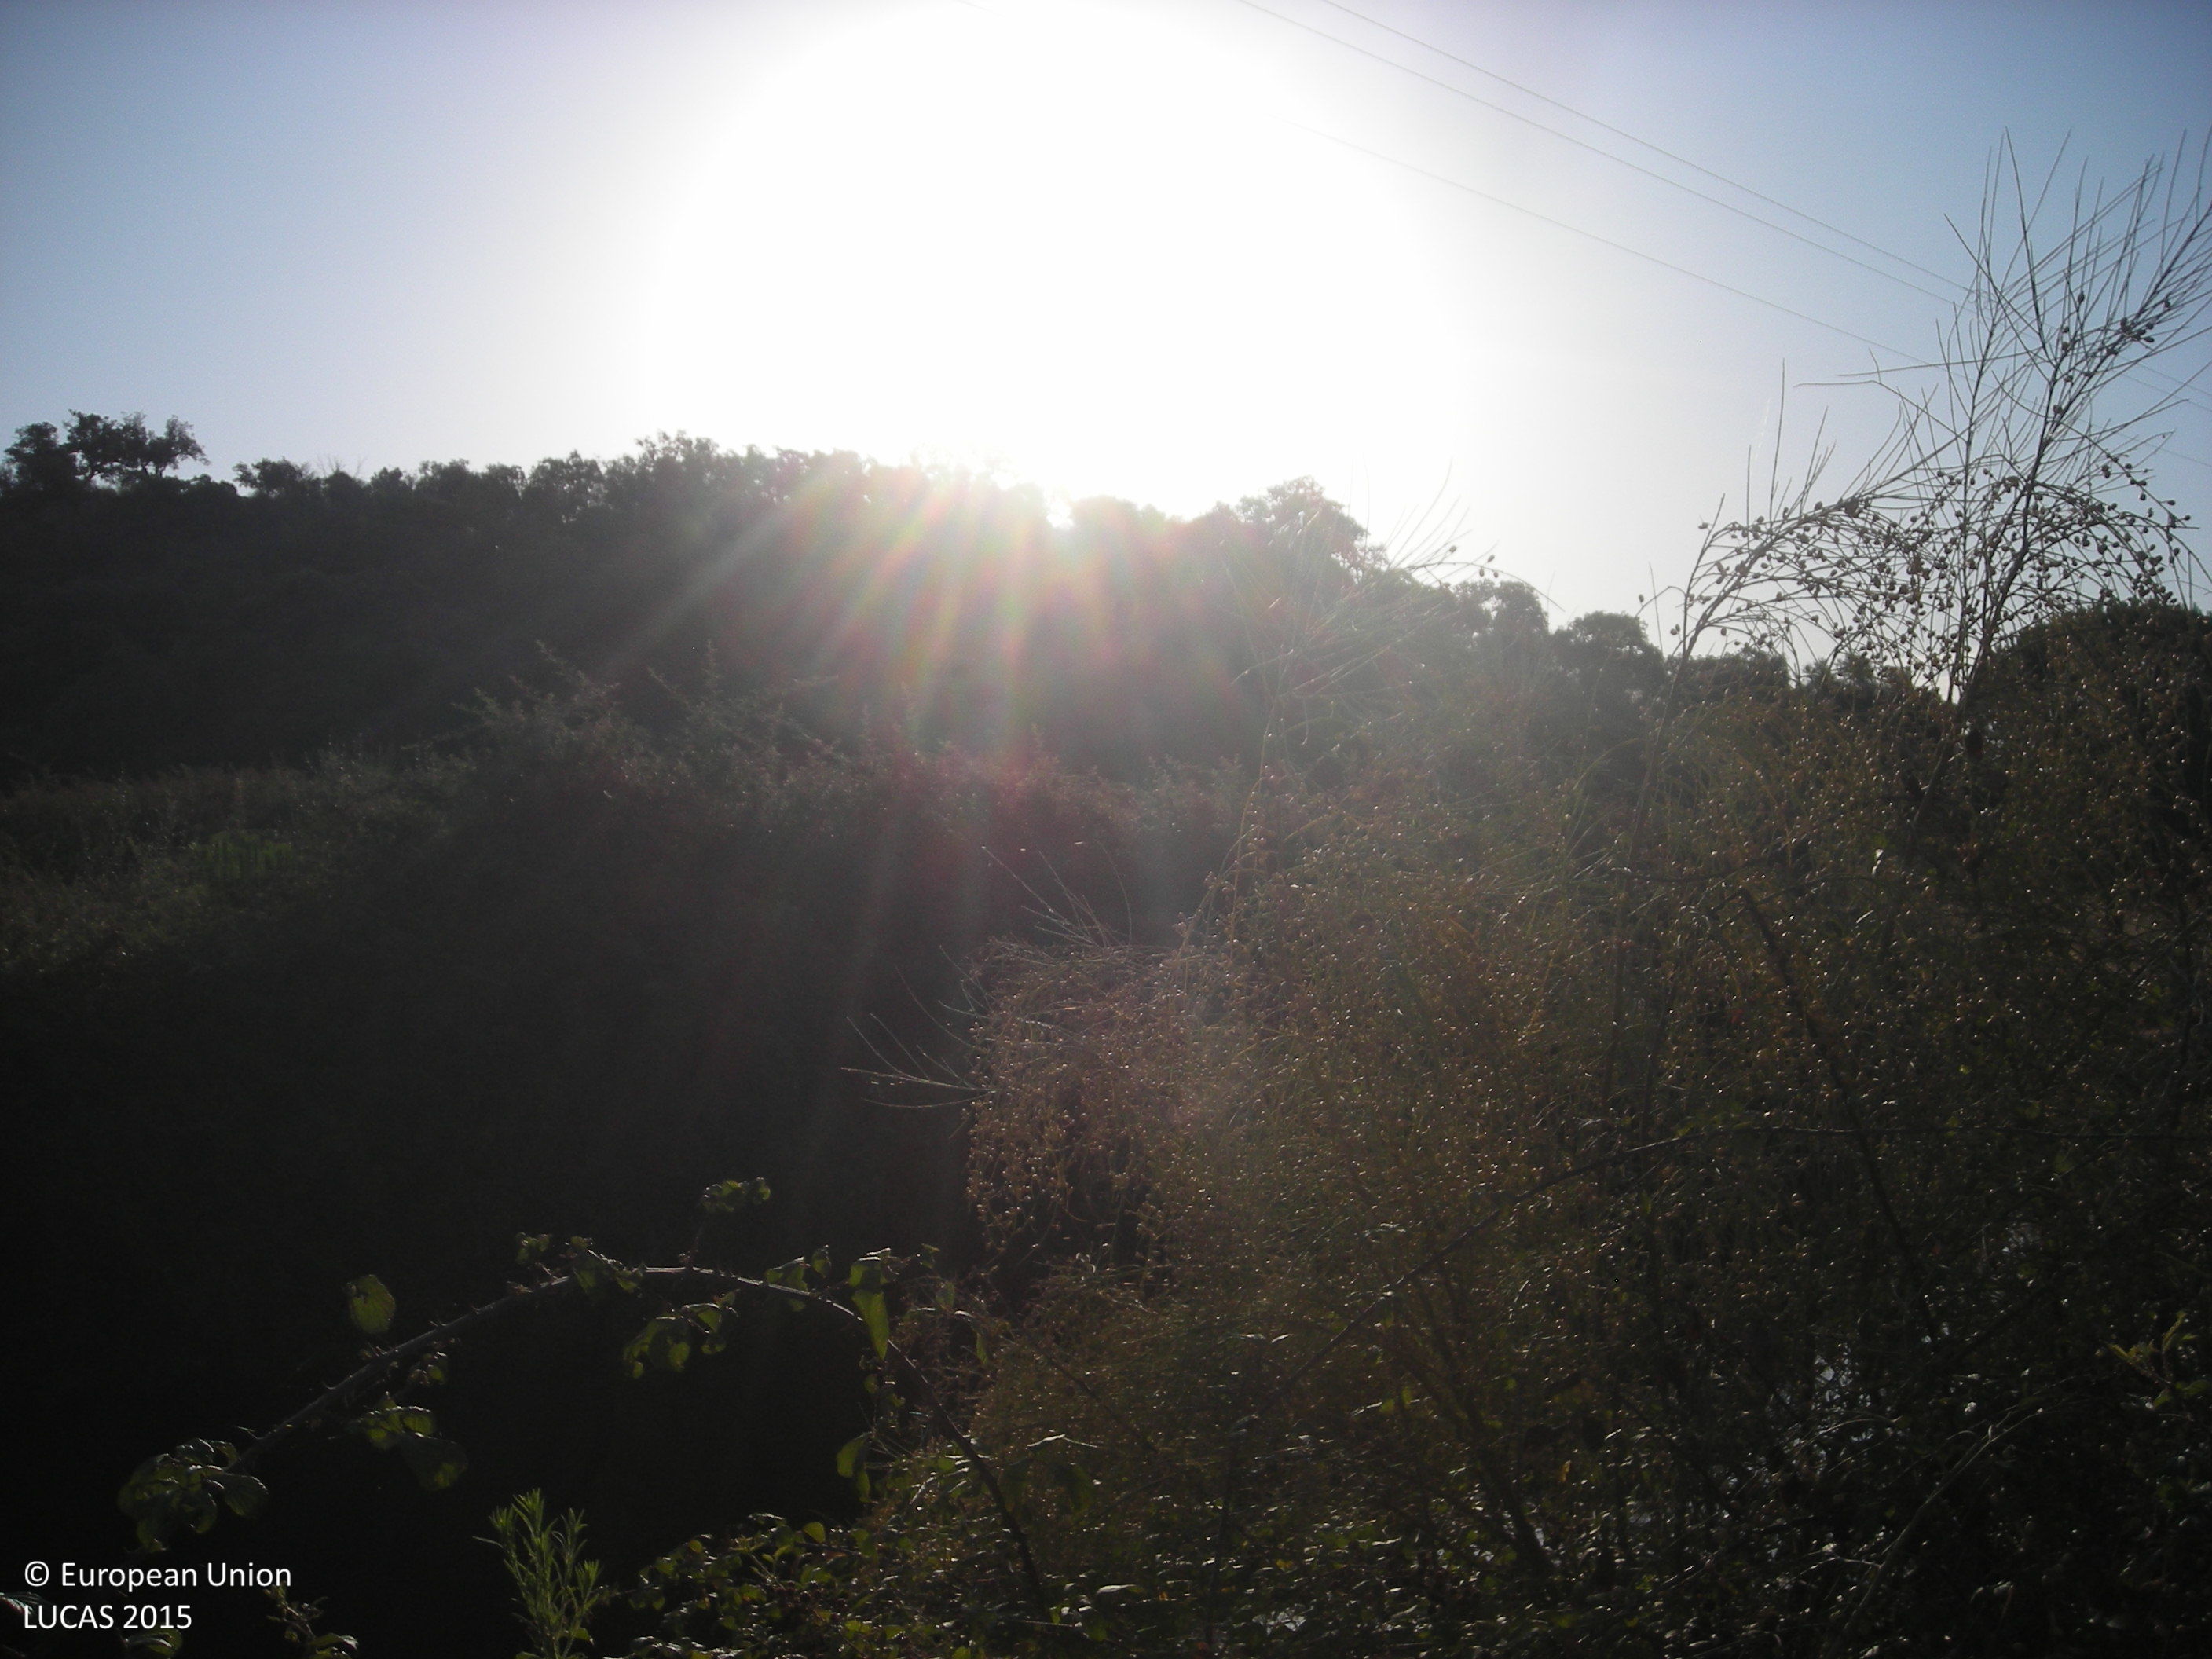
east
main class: Woodland
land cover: Broadleaved woodland
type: broadleaved evergreen forest
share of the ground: 50 - 75 %
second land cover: Grassland without tree/shrub cover
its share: 50 - 75 %
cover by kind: broadleaved forest trees 60 %, herbaceous plants 40 %
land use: Forestry
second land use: Agriculture (excluding fallow land and kitchen gardens)
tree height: > 5 m
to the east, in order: Broadleaved woodland; Grassland without tree/shrub cover
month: July
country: ES
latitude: 39.1491
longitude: -5.9882
